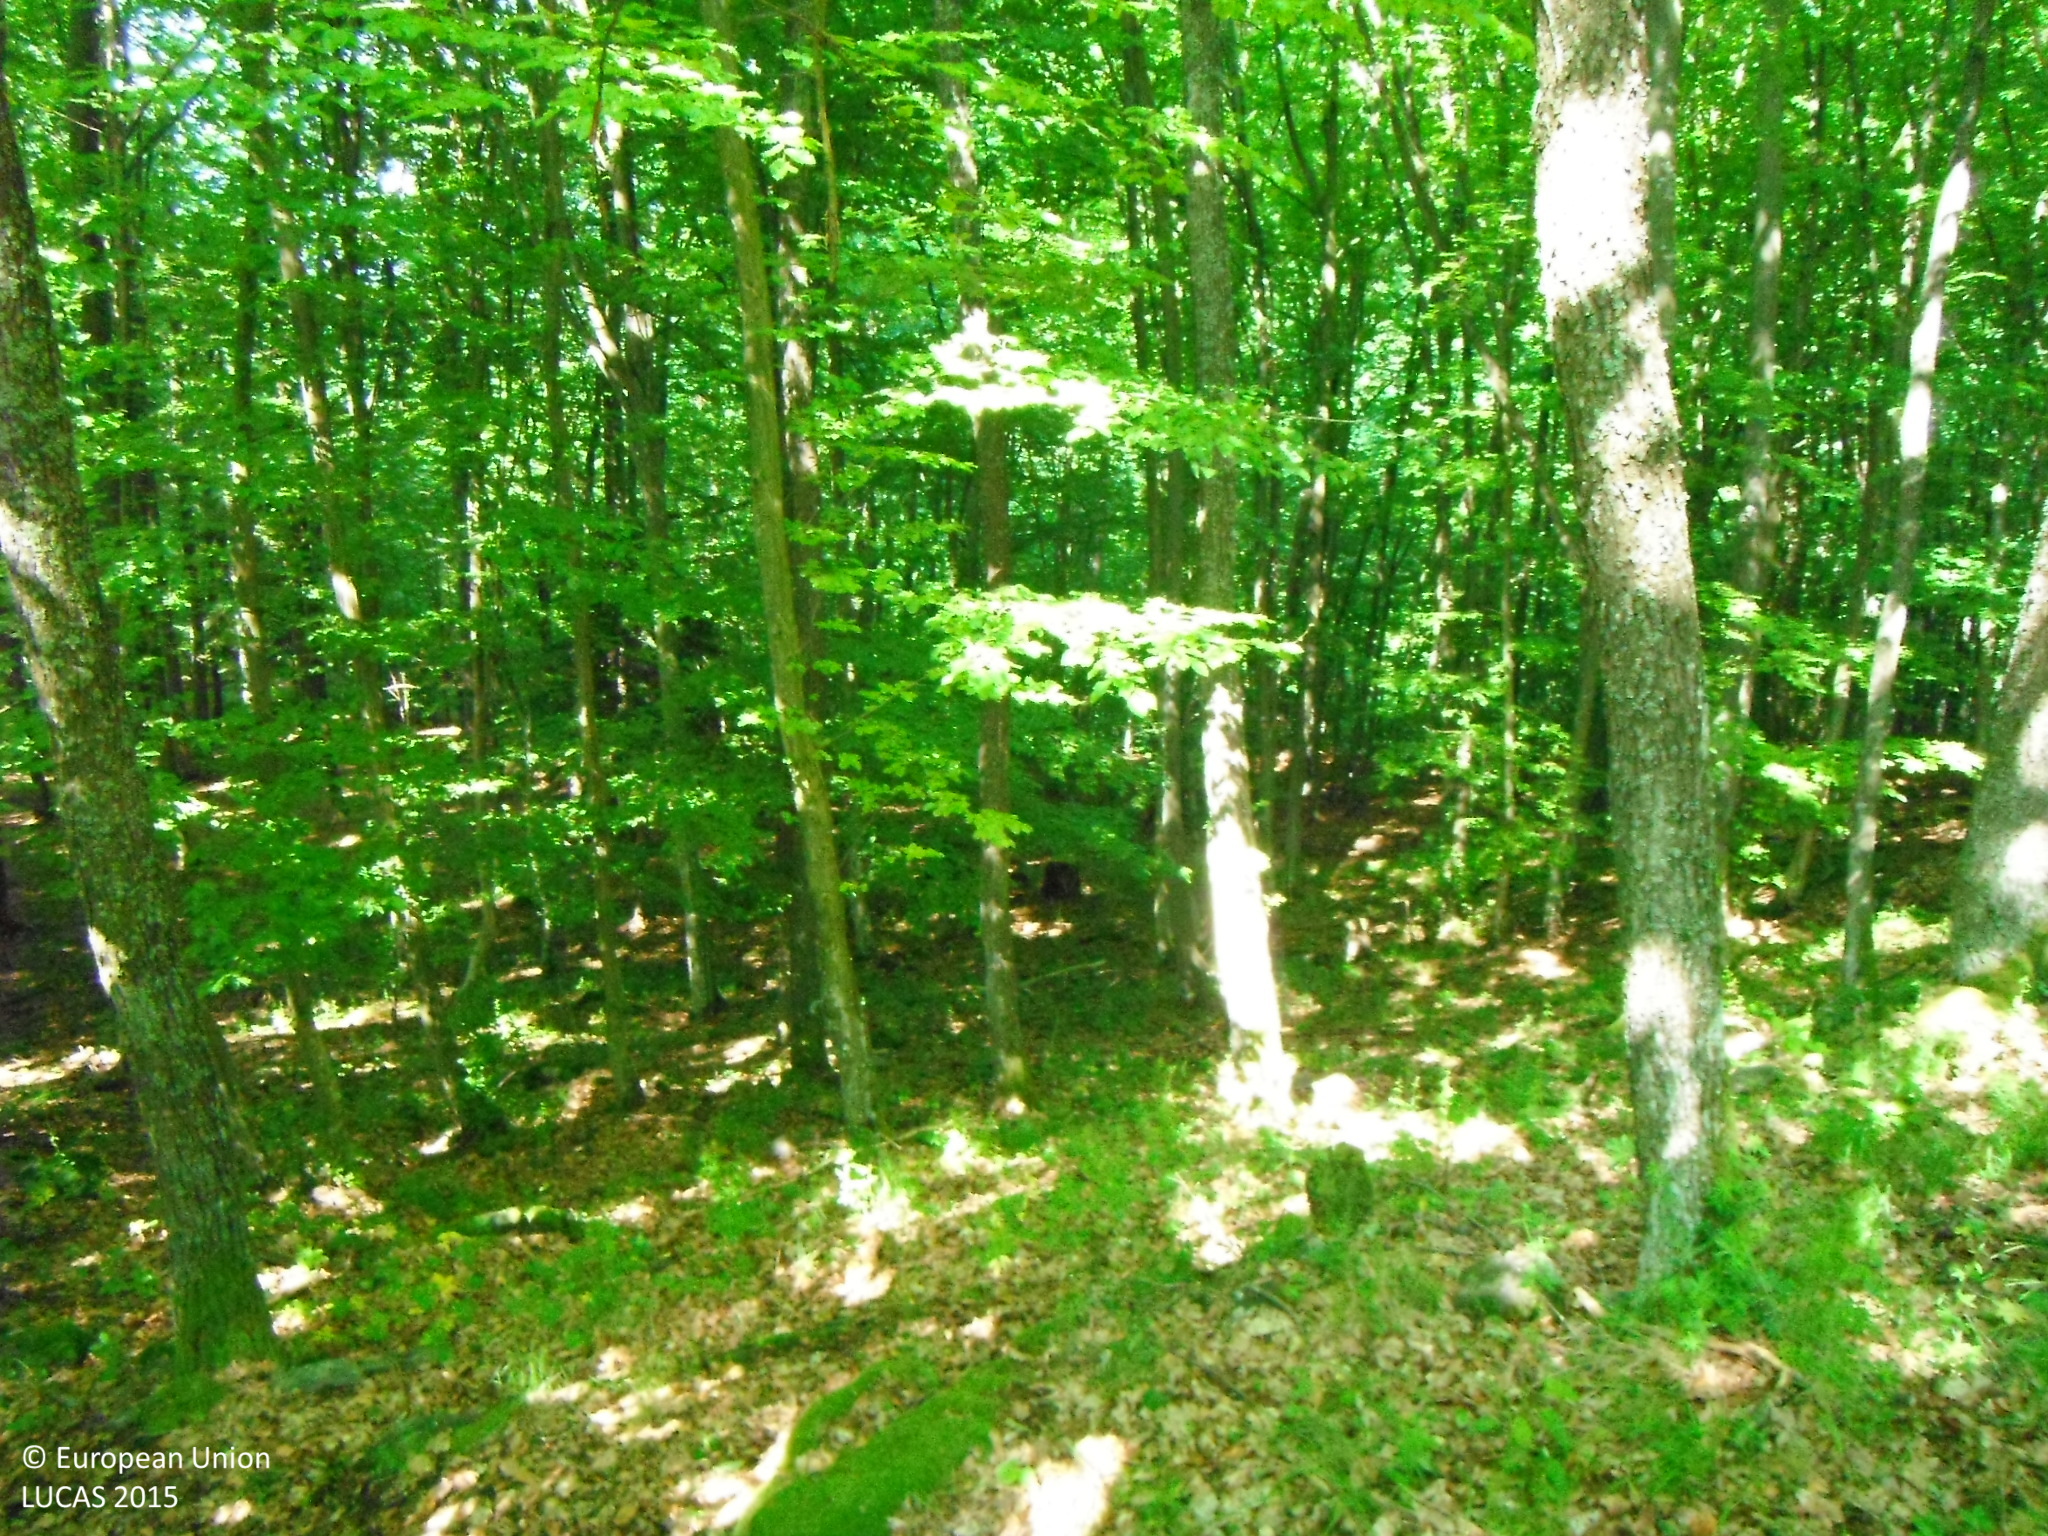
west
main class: Woodland
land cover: Broadleaved woodland
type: acidophilous oak and oak-birch forest
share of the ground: > 75 %
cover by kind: broadleaved forest trees 95 %, herbaceous plants 5 %
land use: Forestry
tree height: > 5 m
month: June
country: SK
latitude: 48.5981
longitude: 19.4214
